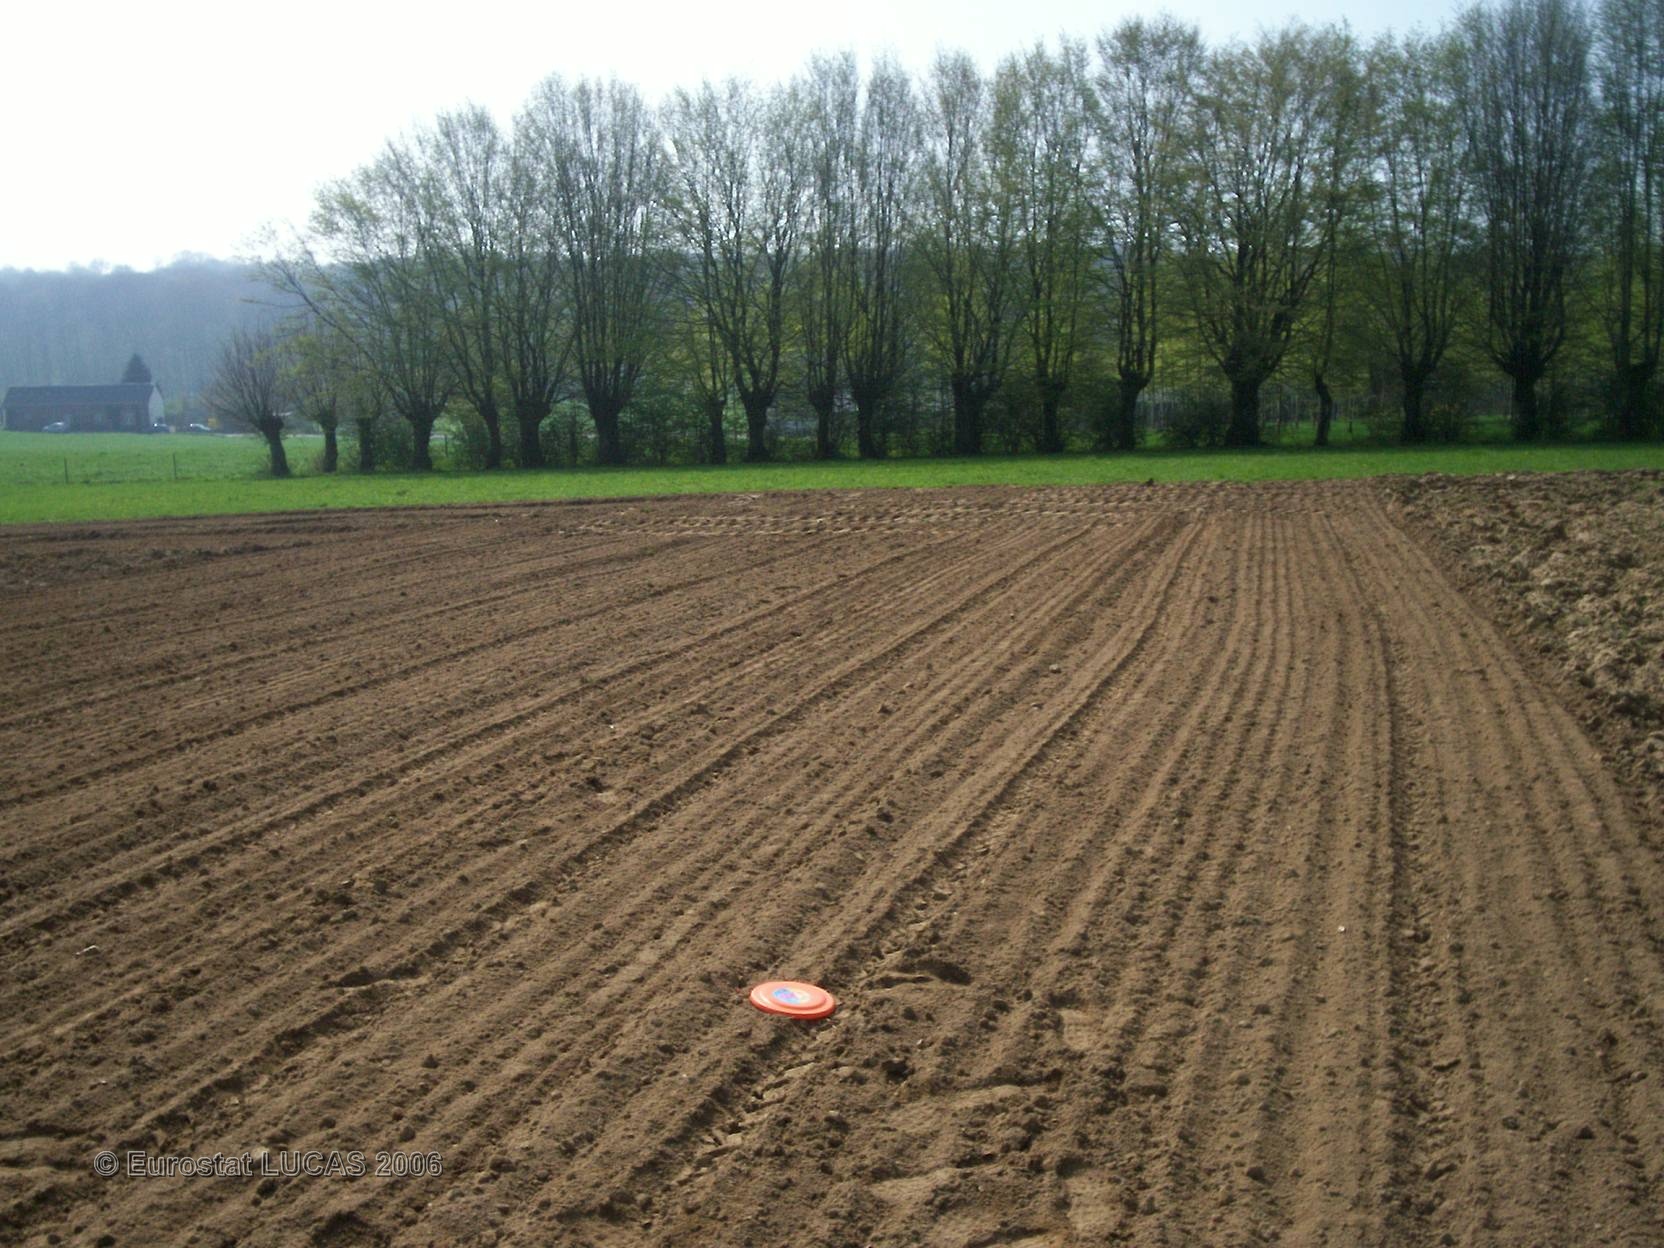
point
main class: Cropland
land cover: Maize
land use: Agriculture (excluding fallow land and kitchen gardens)
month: April
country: FR
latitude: 50.0131
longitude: 3.7557
